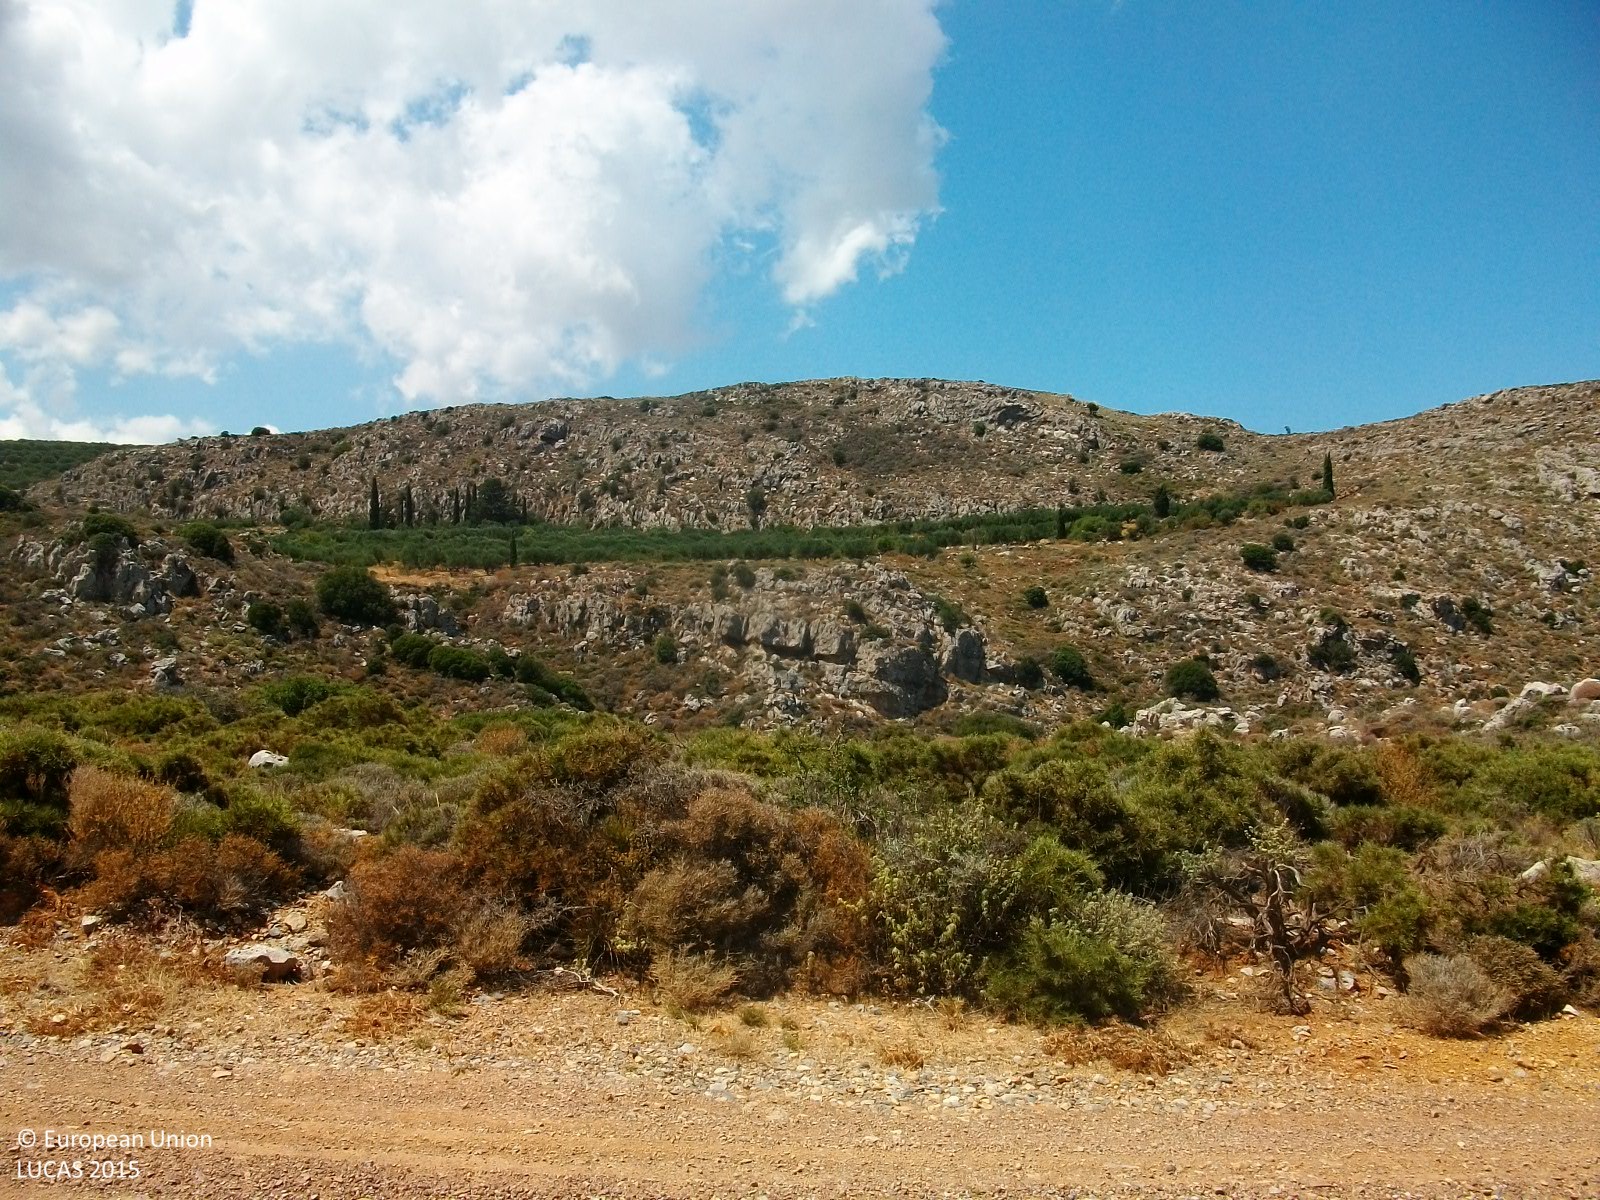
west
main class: Shrubland
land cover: Shrubland without tree cover
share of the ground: 50 - 75 %
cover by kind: shrubs 60 %, unconsolidated bare surface 40 %
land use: Semi-natural and natural areas not in use
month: August
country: GR
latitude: 35.1074
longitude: 26.1172
